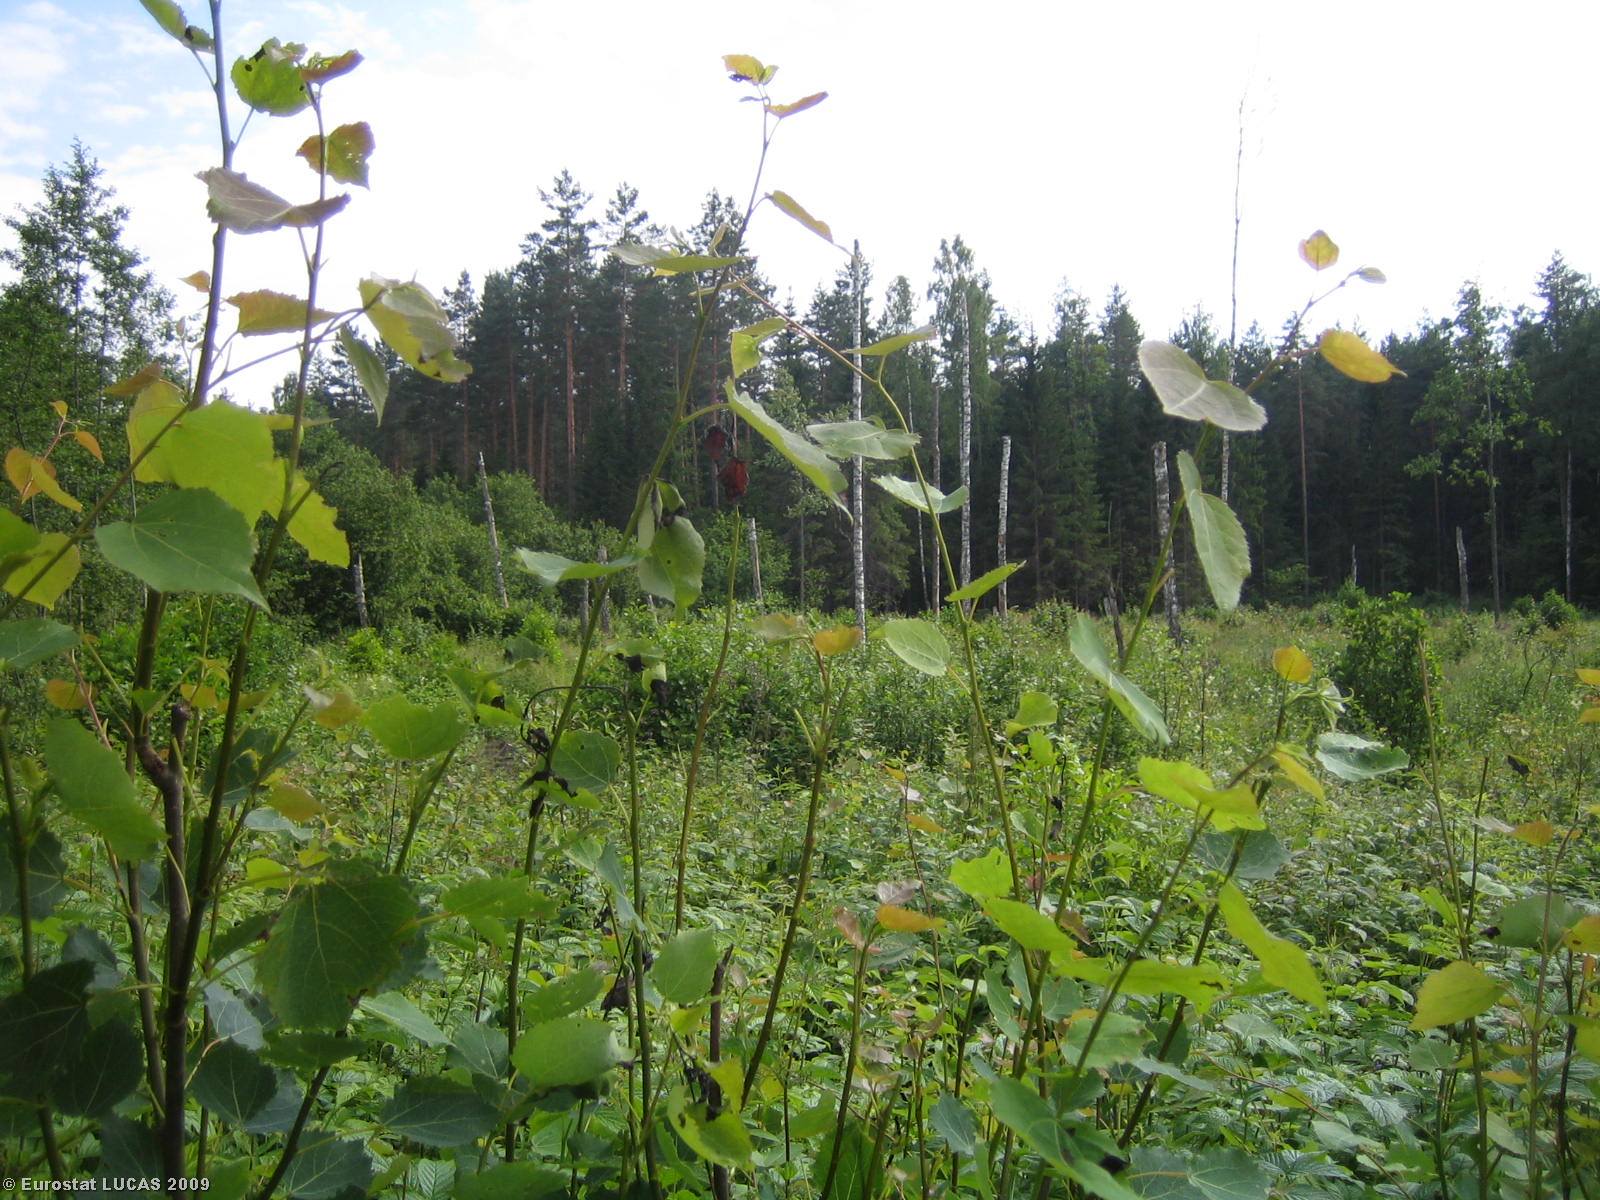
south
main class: Woodland
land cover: Mixed woodland
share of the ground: > 75 %
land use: Forestry
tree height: < 5 m
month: July
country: LT
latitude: 55.6889
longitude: 25.9963
